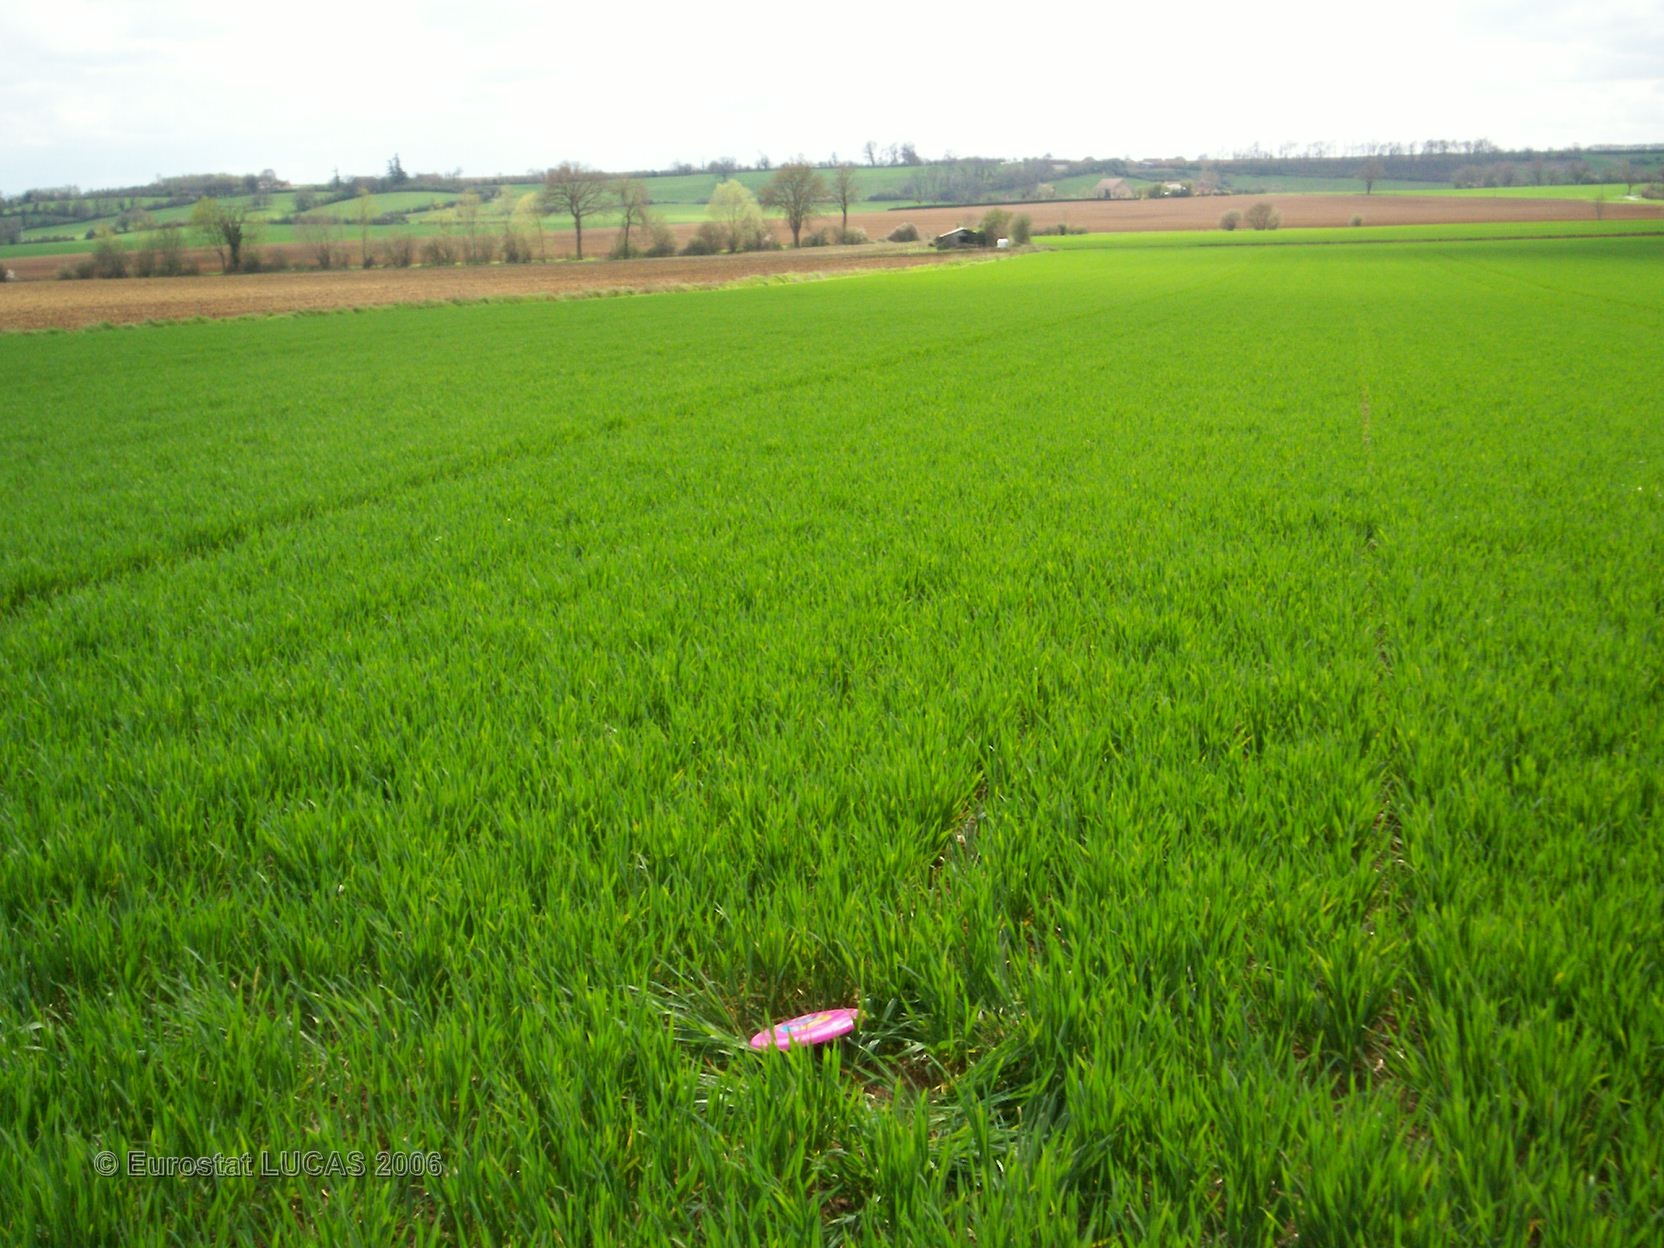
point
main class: Cropland
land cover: Common wheat
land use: Agriculture (excluding fallow land and kitchen gardens)
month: April
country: FR
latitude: 48.3053
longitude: 0.3345
